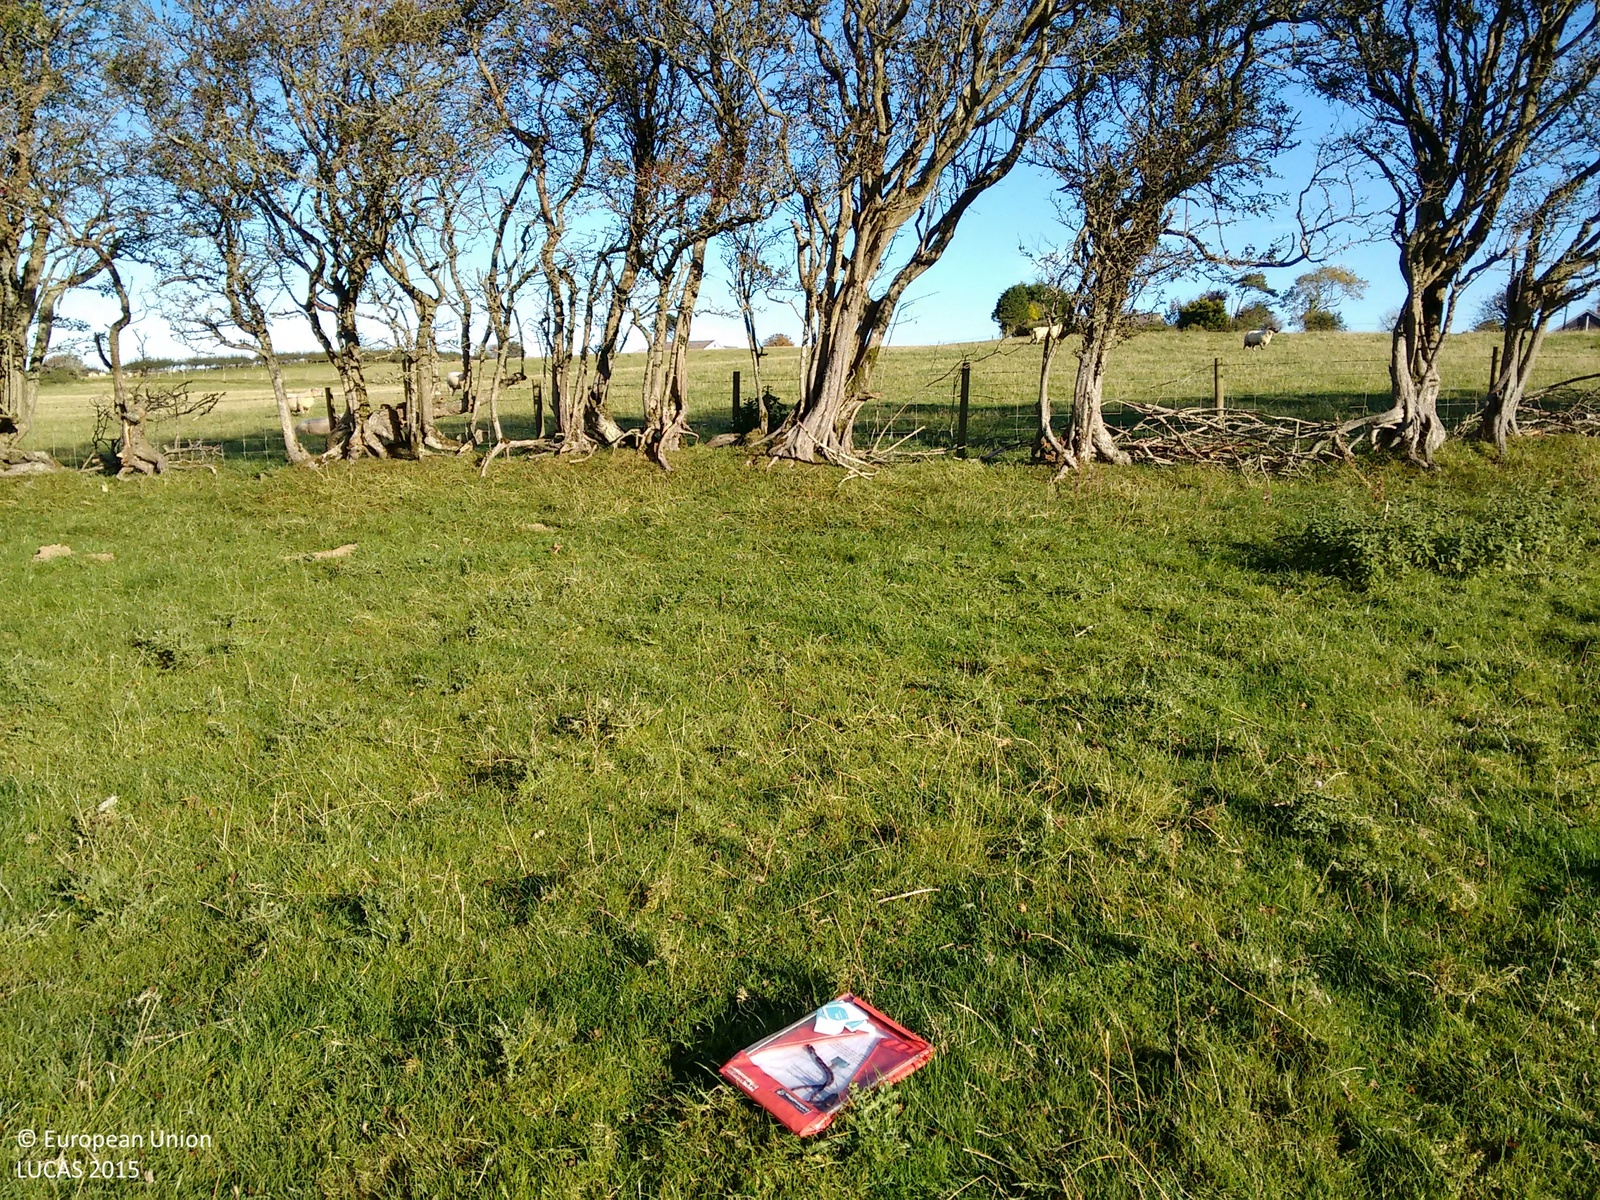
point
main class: Grassland
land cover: Grassland without tree/shrub cover
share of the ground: > 75 %
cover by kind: herbaceous plants 100 %
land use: Agriculture (excluding fallow land and kitchen gardens)
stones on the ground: < 10 %
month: October
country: GB
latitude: 52.3848
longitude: -3.9784
